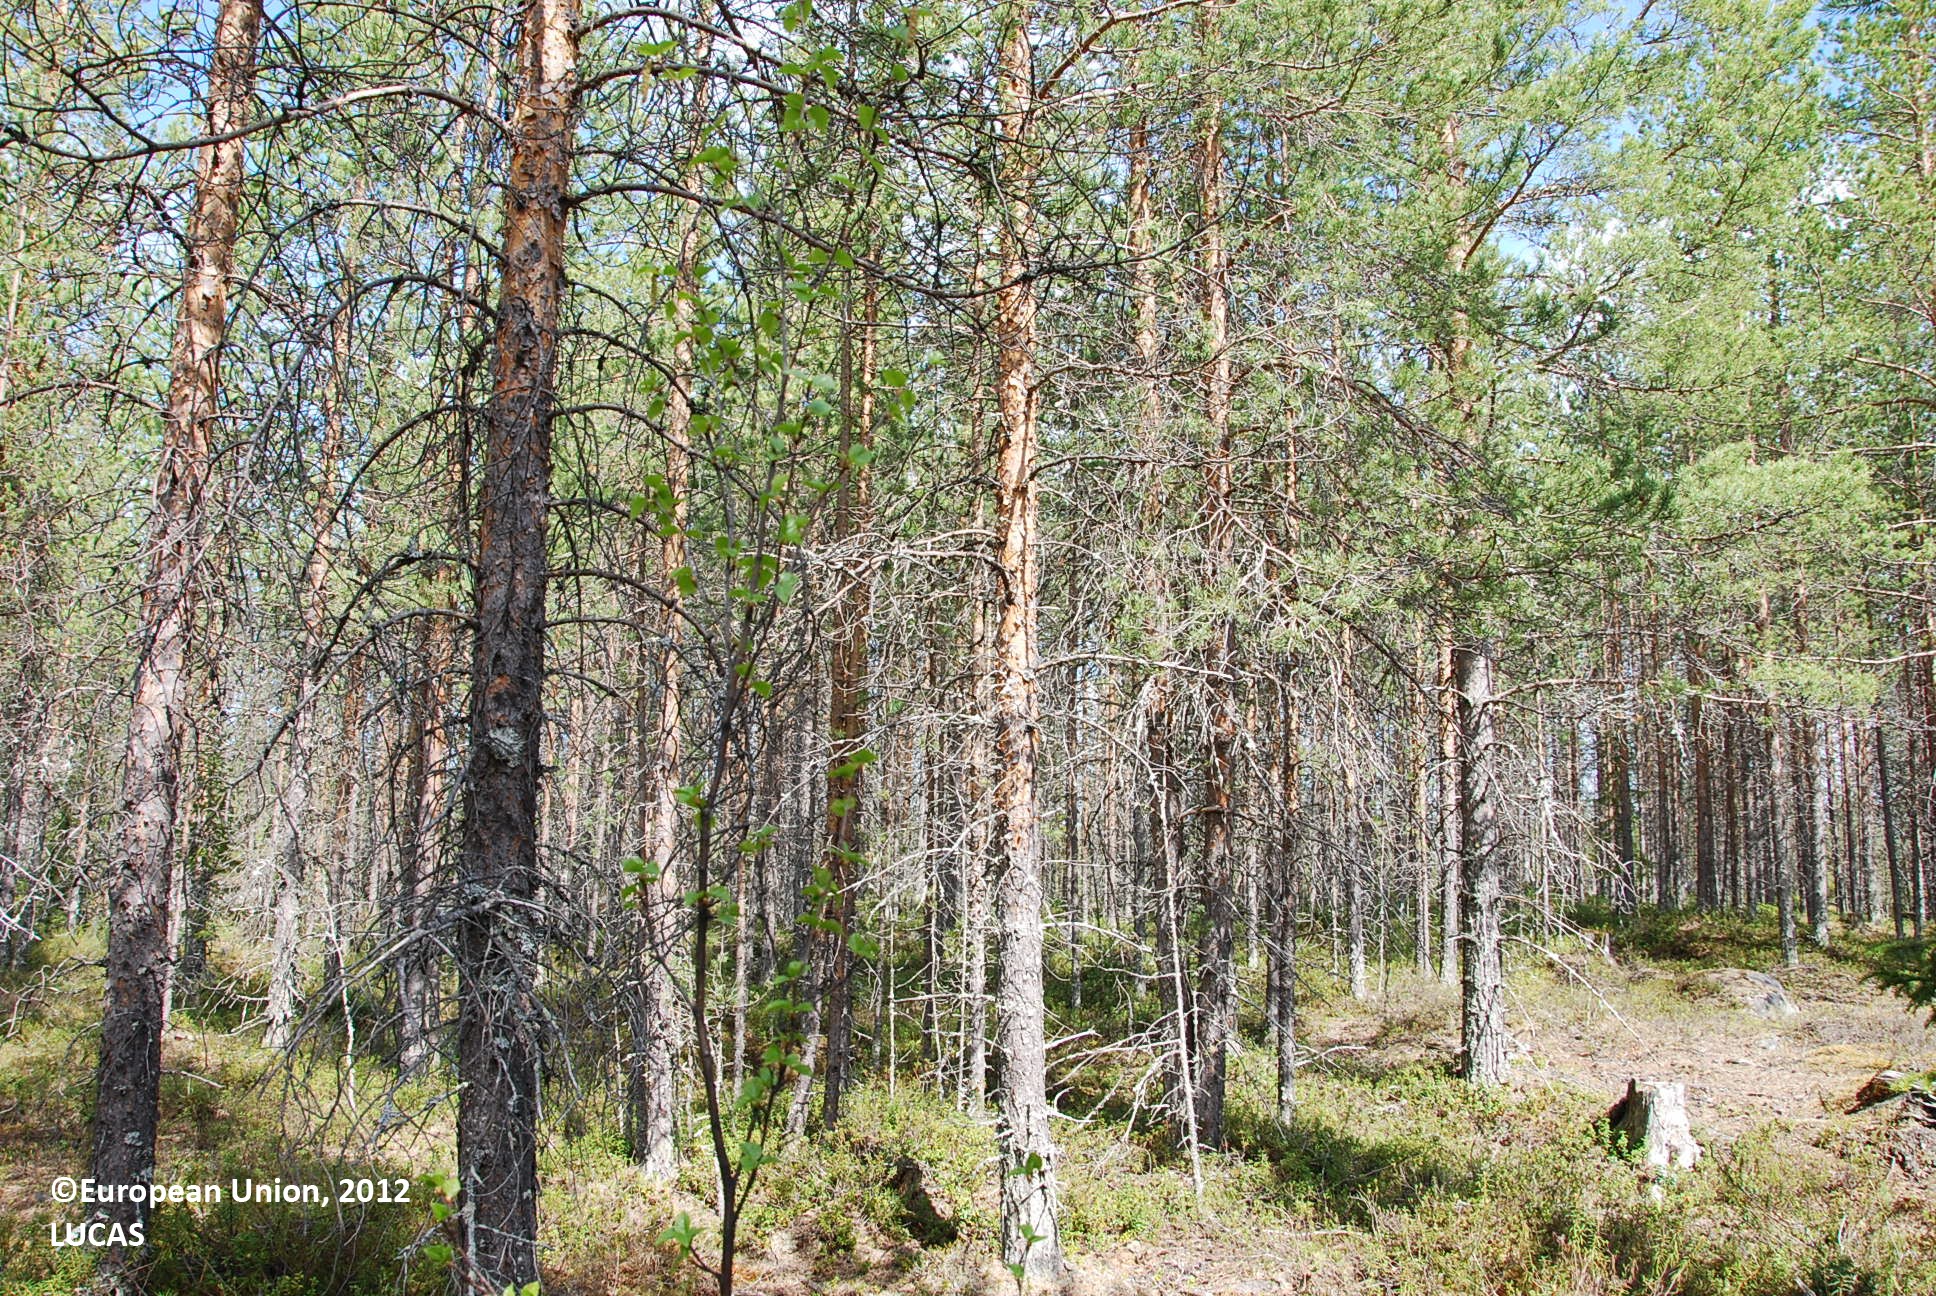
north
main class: Woodland
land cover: Pine dominated coniferous woodland
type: boreal forest
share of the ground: > 75 %
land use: Forestry
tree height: > 5 m
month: June
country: FI
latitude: 66.6011
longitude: 28.0230
